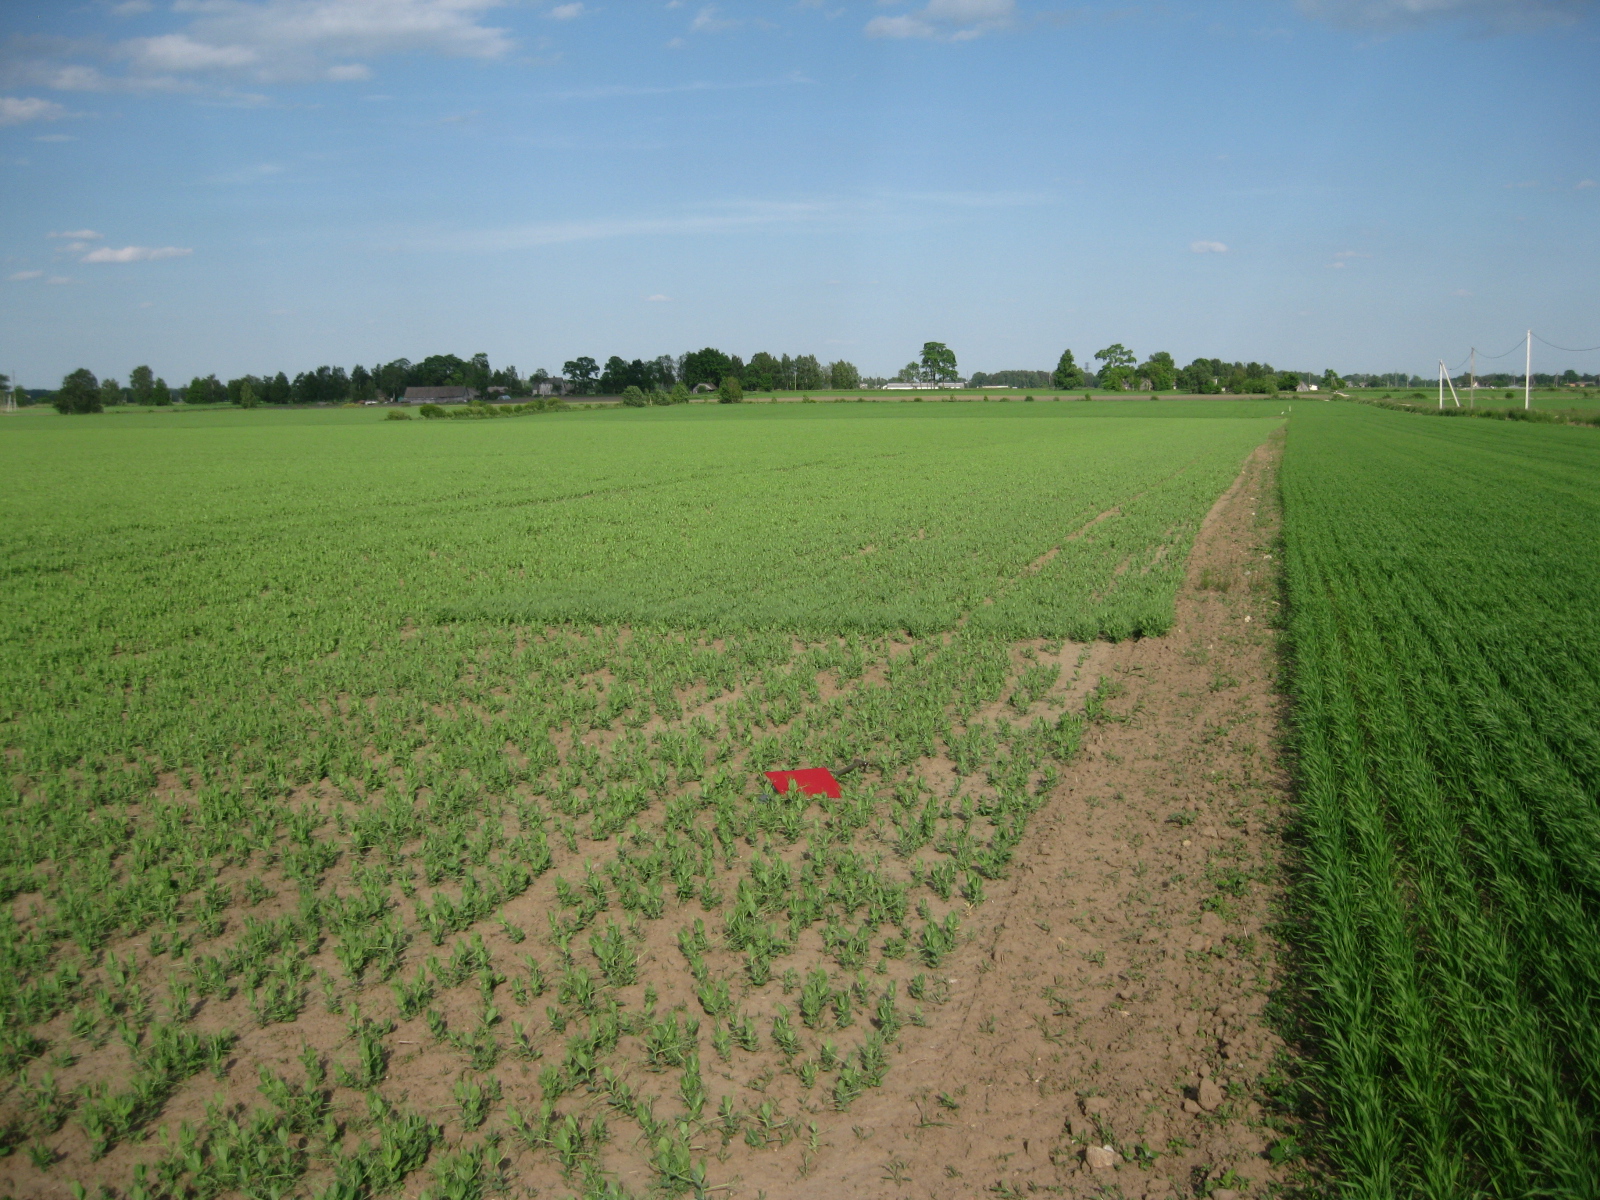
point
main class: Cropland
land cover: Dry pulses
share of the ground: 50 - 75 %
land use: Agriculture (excluding fallow land and kitchen gardens)
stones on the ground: < 10 %
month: June
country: LT
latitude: 55.7517
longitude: 24.0950
